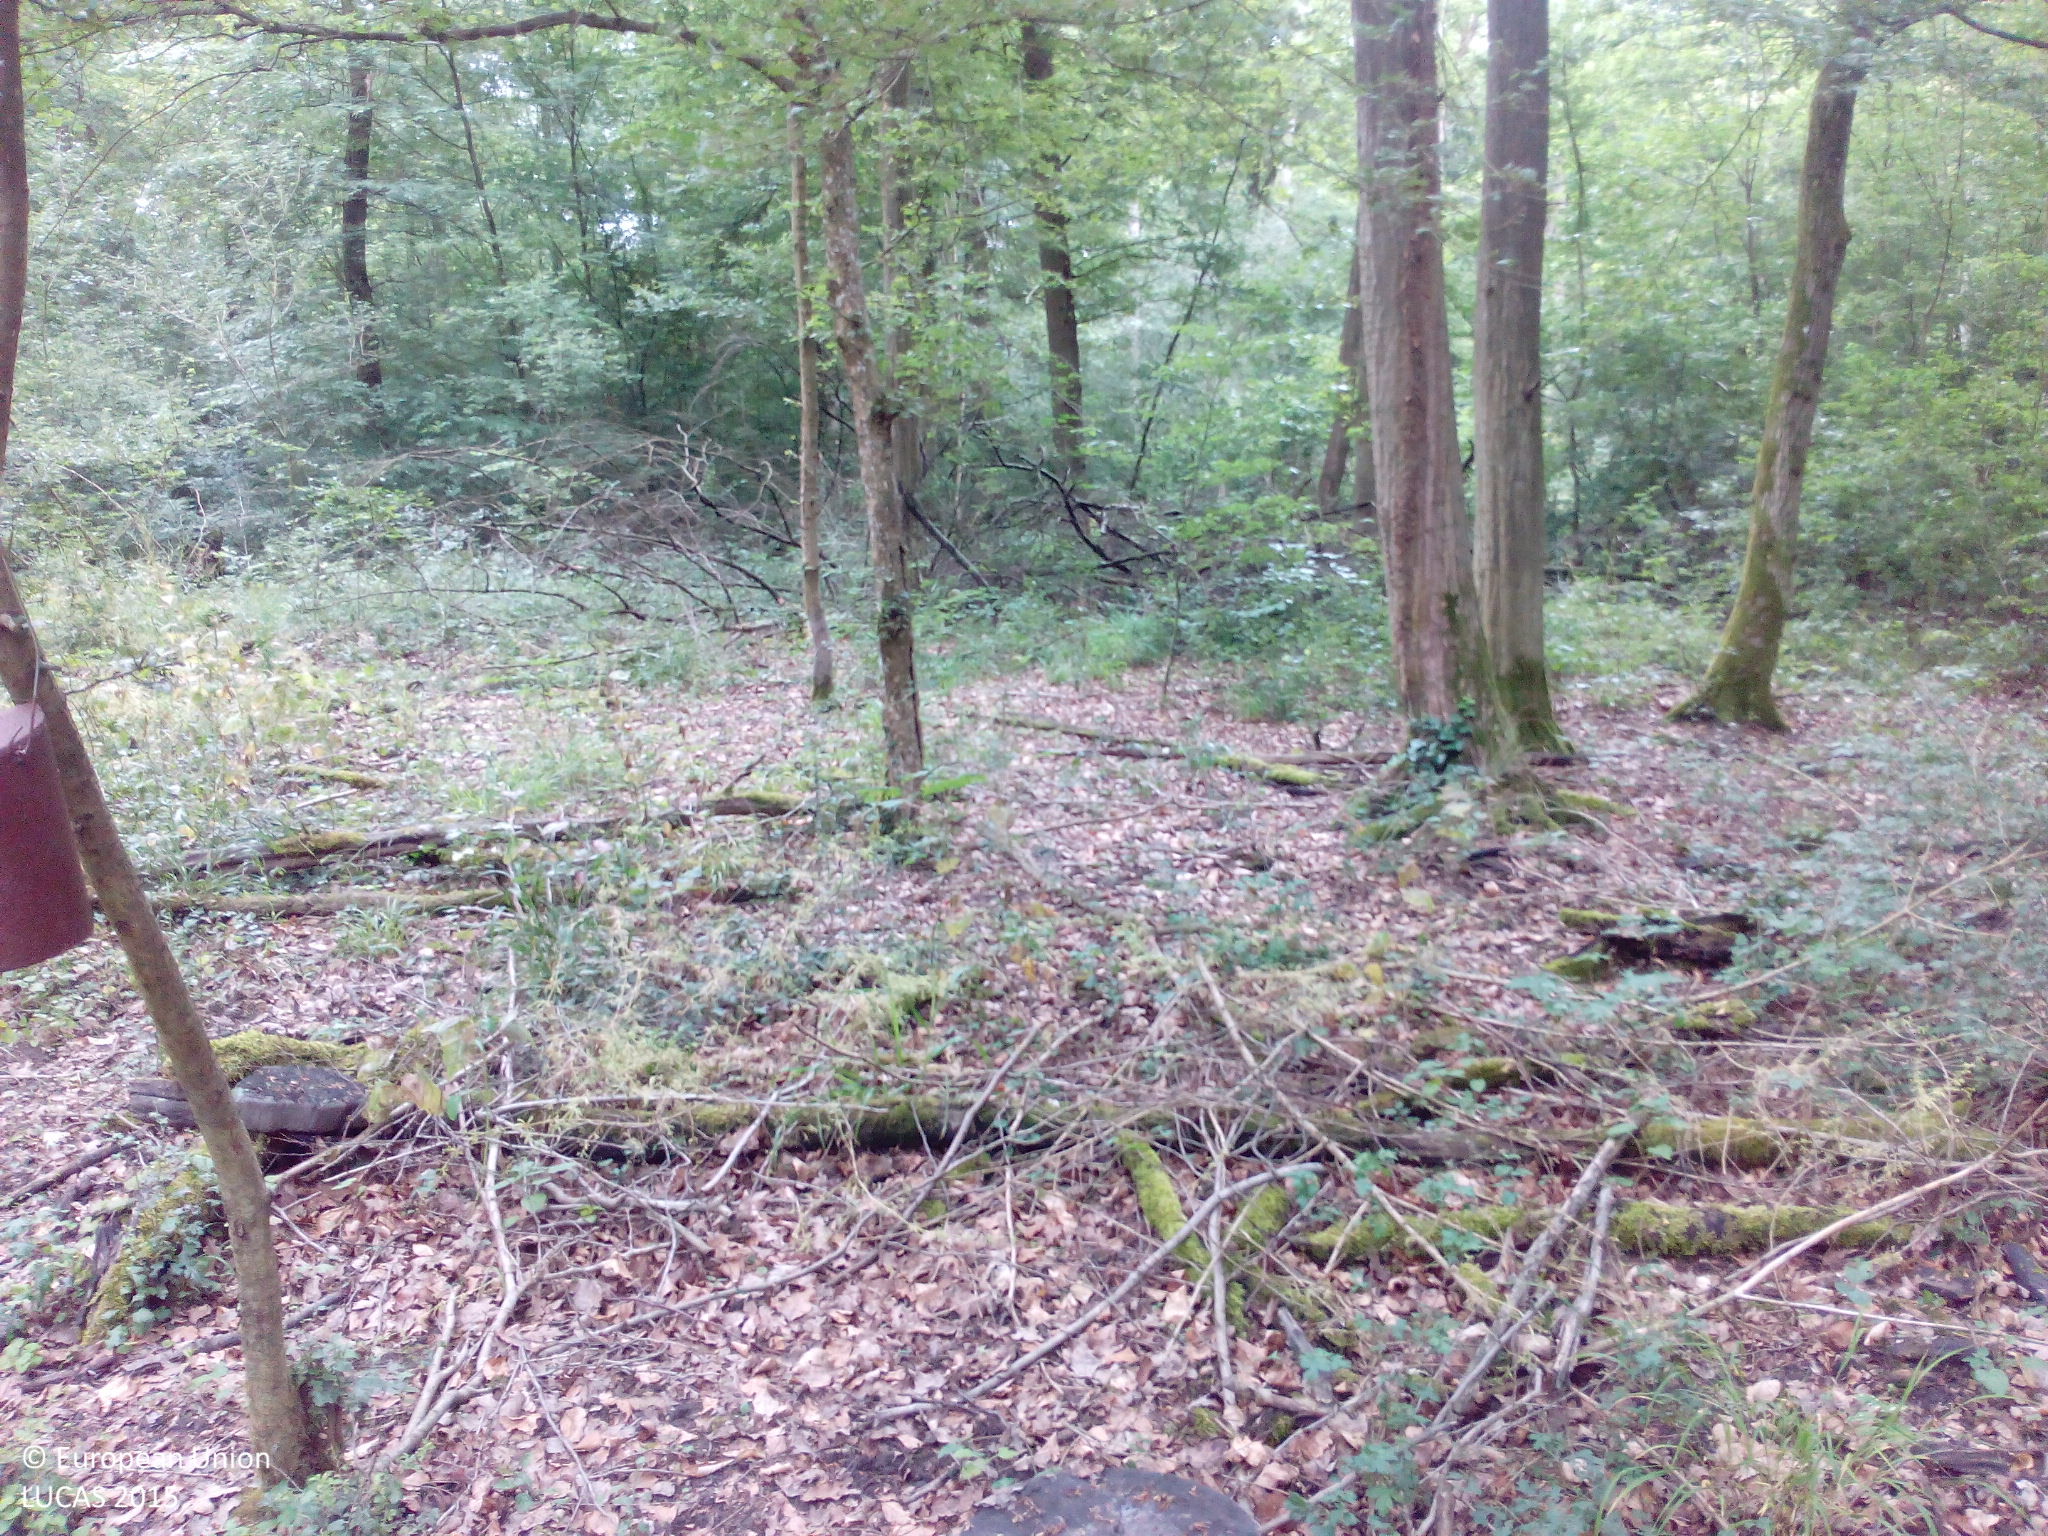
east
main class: Woodland
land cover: Broadleaved woodland
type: mesophytic deciduous forest
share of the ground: 50 - 75 %
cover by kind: broadleaved forest trees 60 %, herbaceous plants 20 %, shrubs 10 %, unconsolidated bare surface 10 %
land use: Forestry
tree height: > 5 m
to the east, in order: Broadleaved woodland; Grass margins; Paved roads, cycling and walking lanes; Shruby margins; Broadleaved woodland
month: June
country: DE
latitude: 49.7073
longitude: 8.5444
